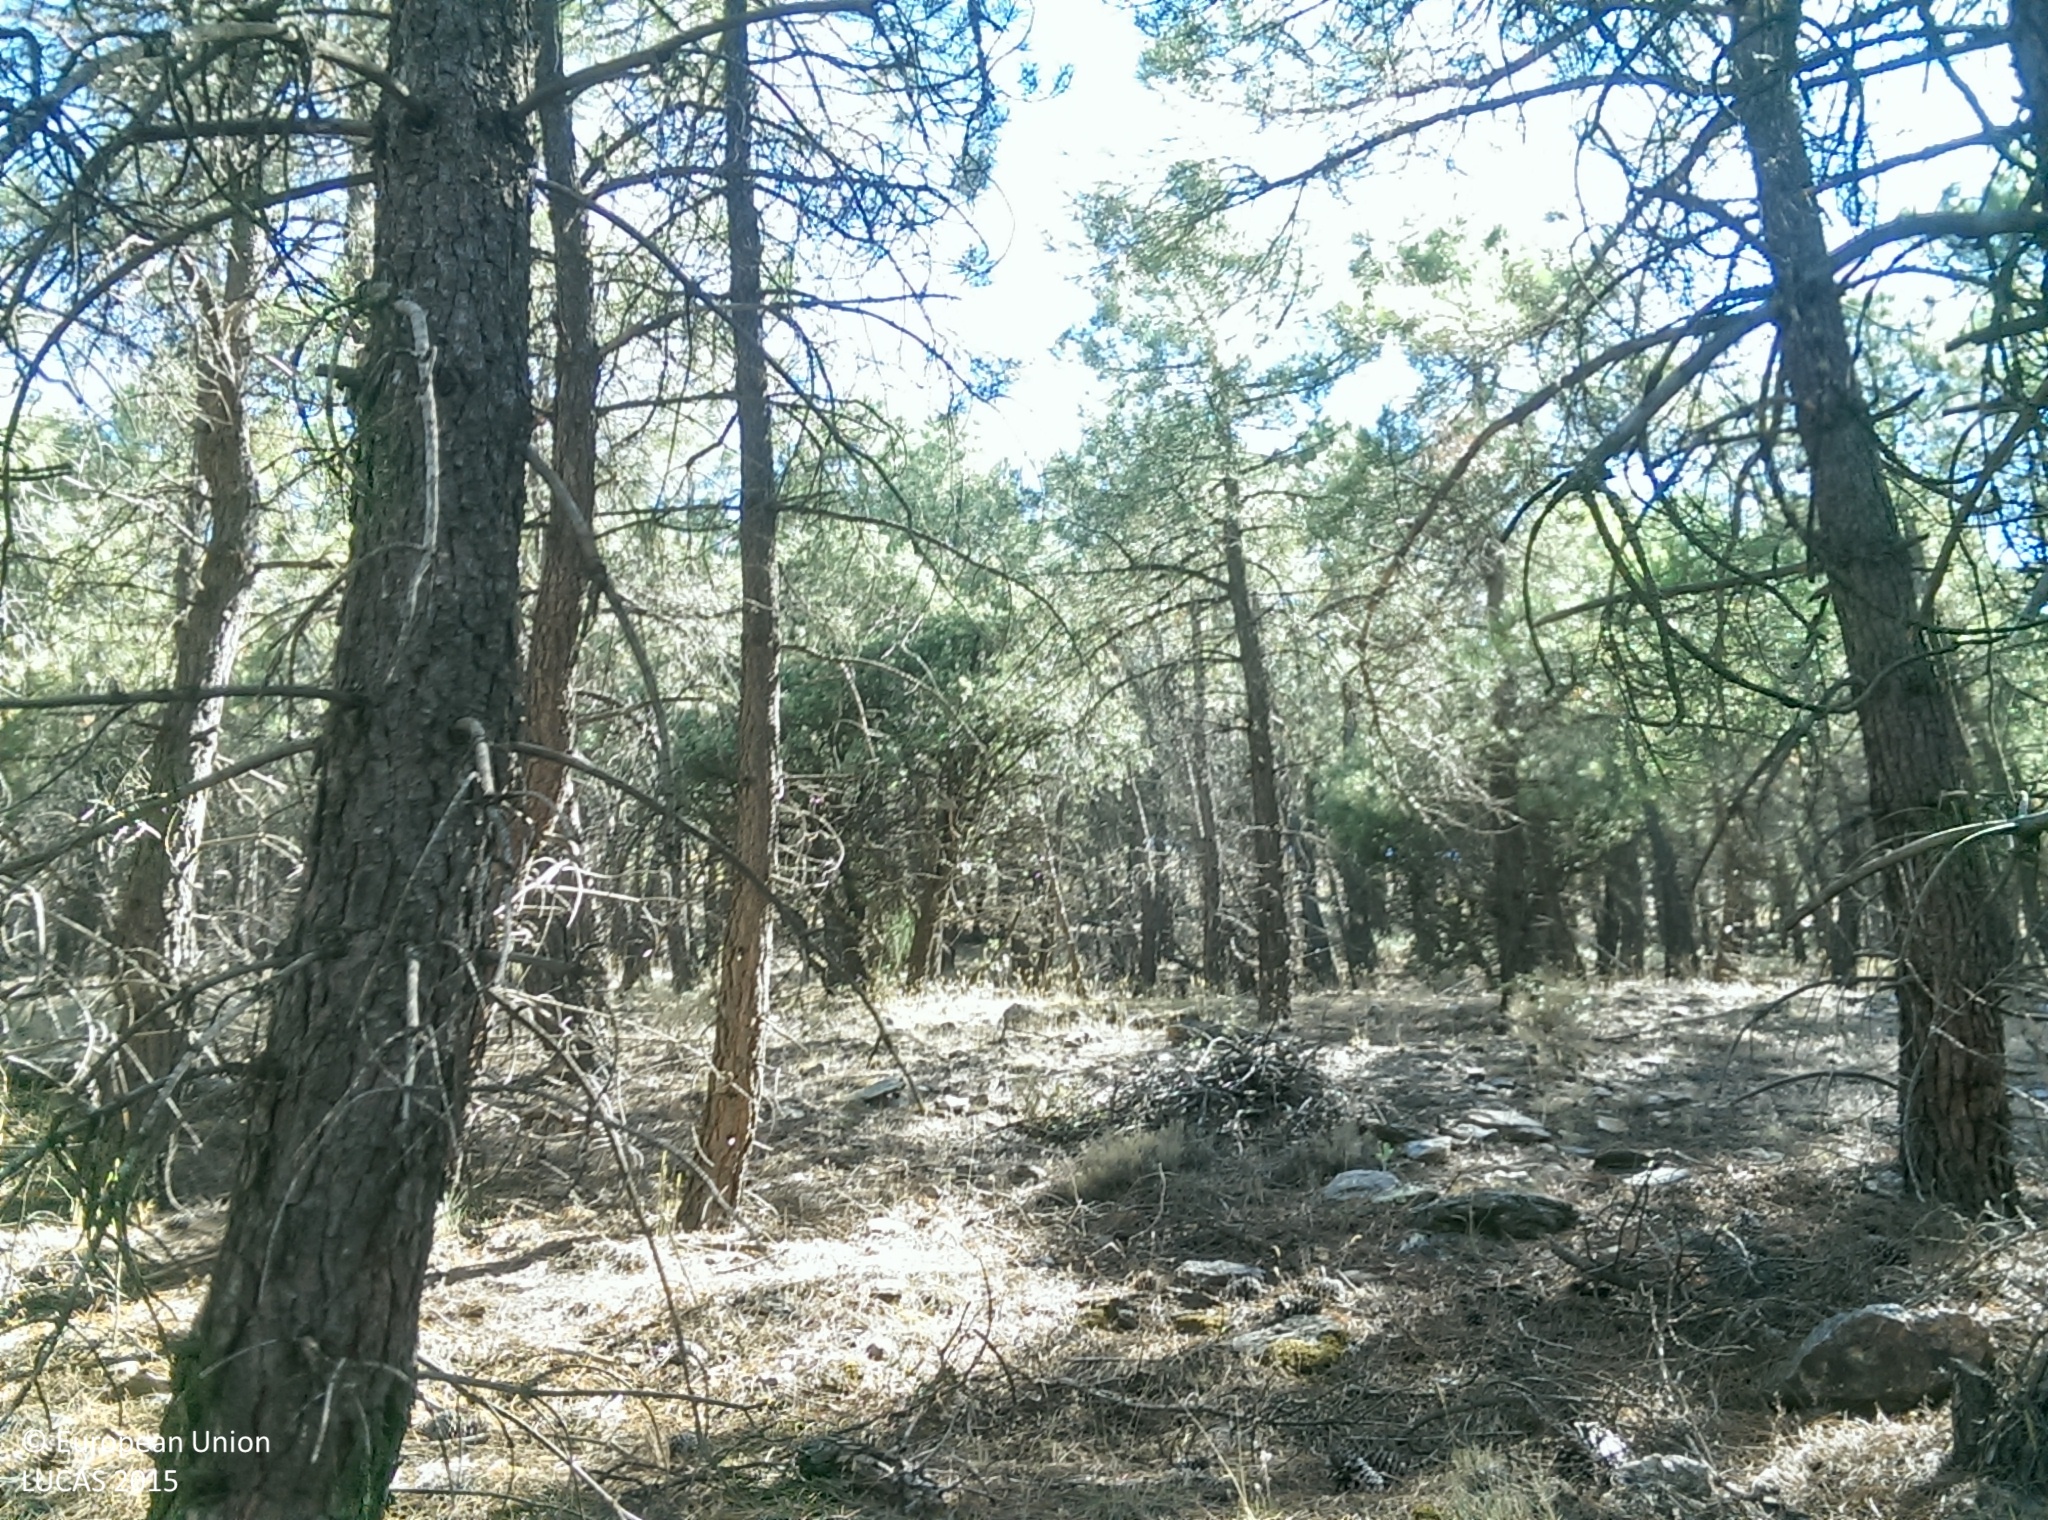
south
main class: Woodland
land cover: Pine dominated coniferous woodland
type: coniferous forest of the mediterranean region
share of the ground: > 75 %
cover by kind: coniferous forest trees 100 %
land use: Forestry
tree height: > 5 m
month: July
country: ES
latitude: 37.1457
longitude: -3.1233
